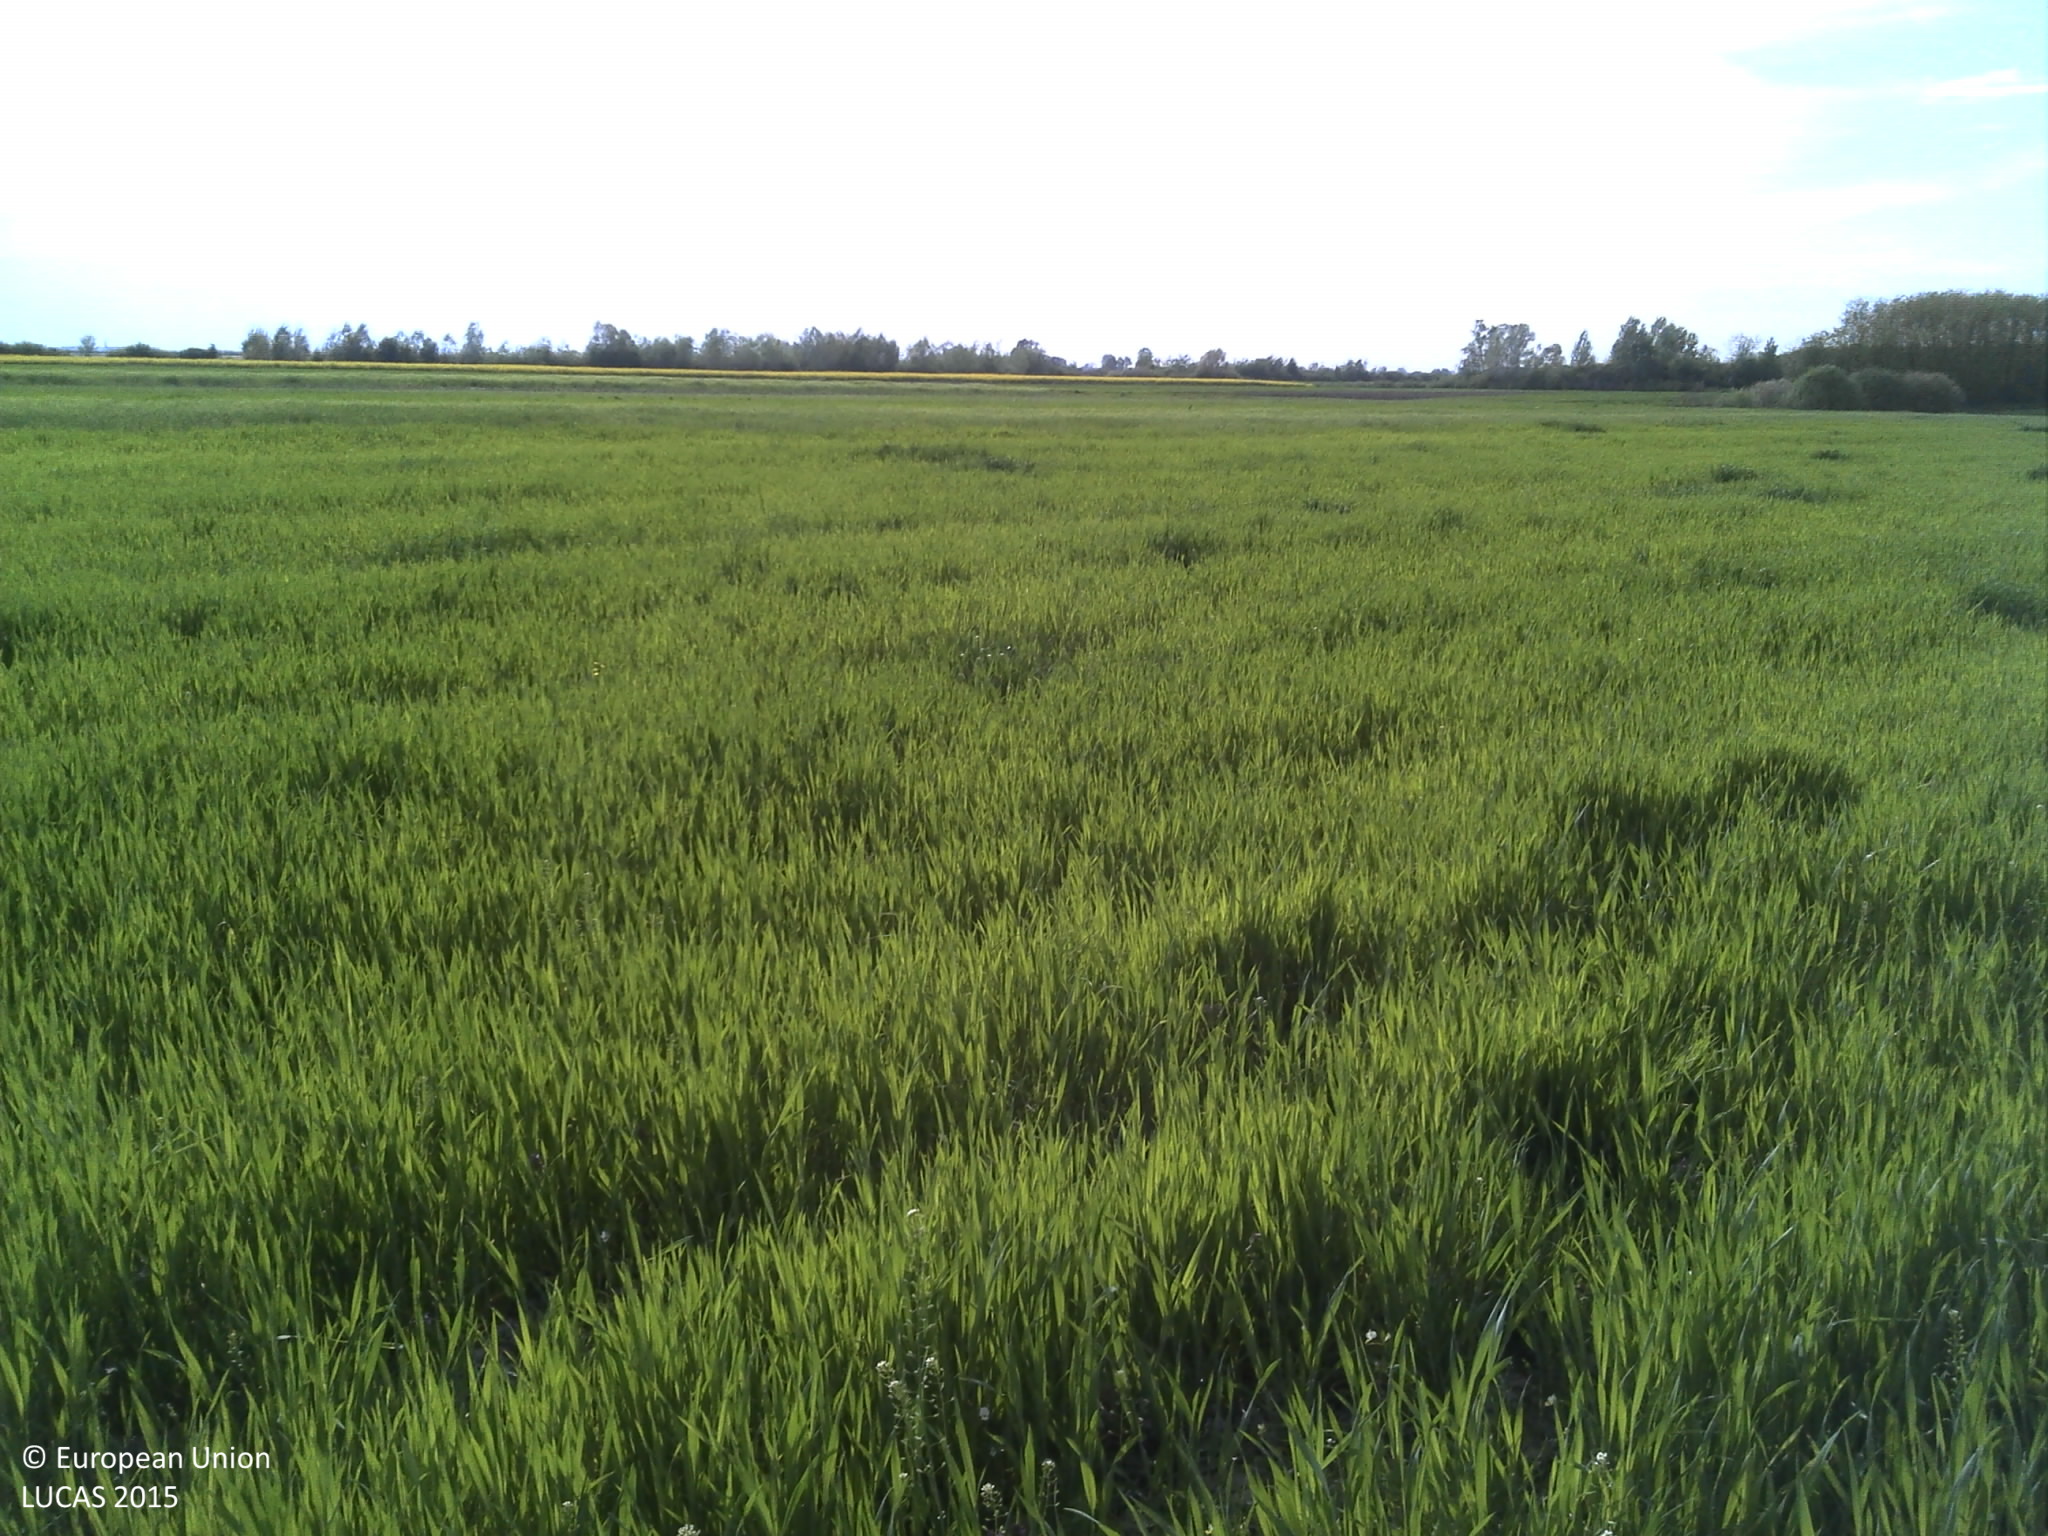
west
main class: Cropland
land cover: Common wheat
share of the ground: > 75 %
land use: Agriculture (excluding fallow land and kitchen gardens)
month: April
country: HR
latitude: 45.0633
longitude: 18.8072
